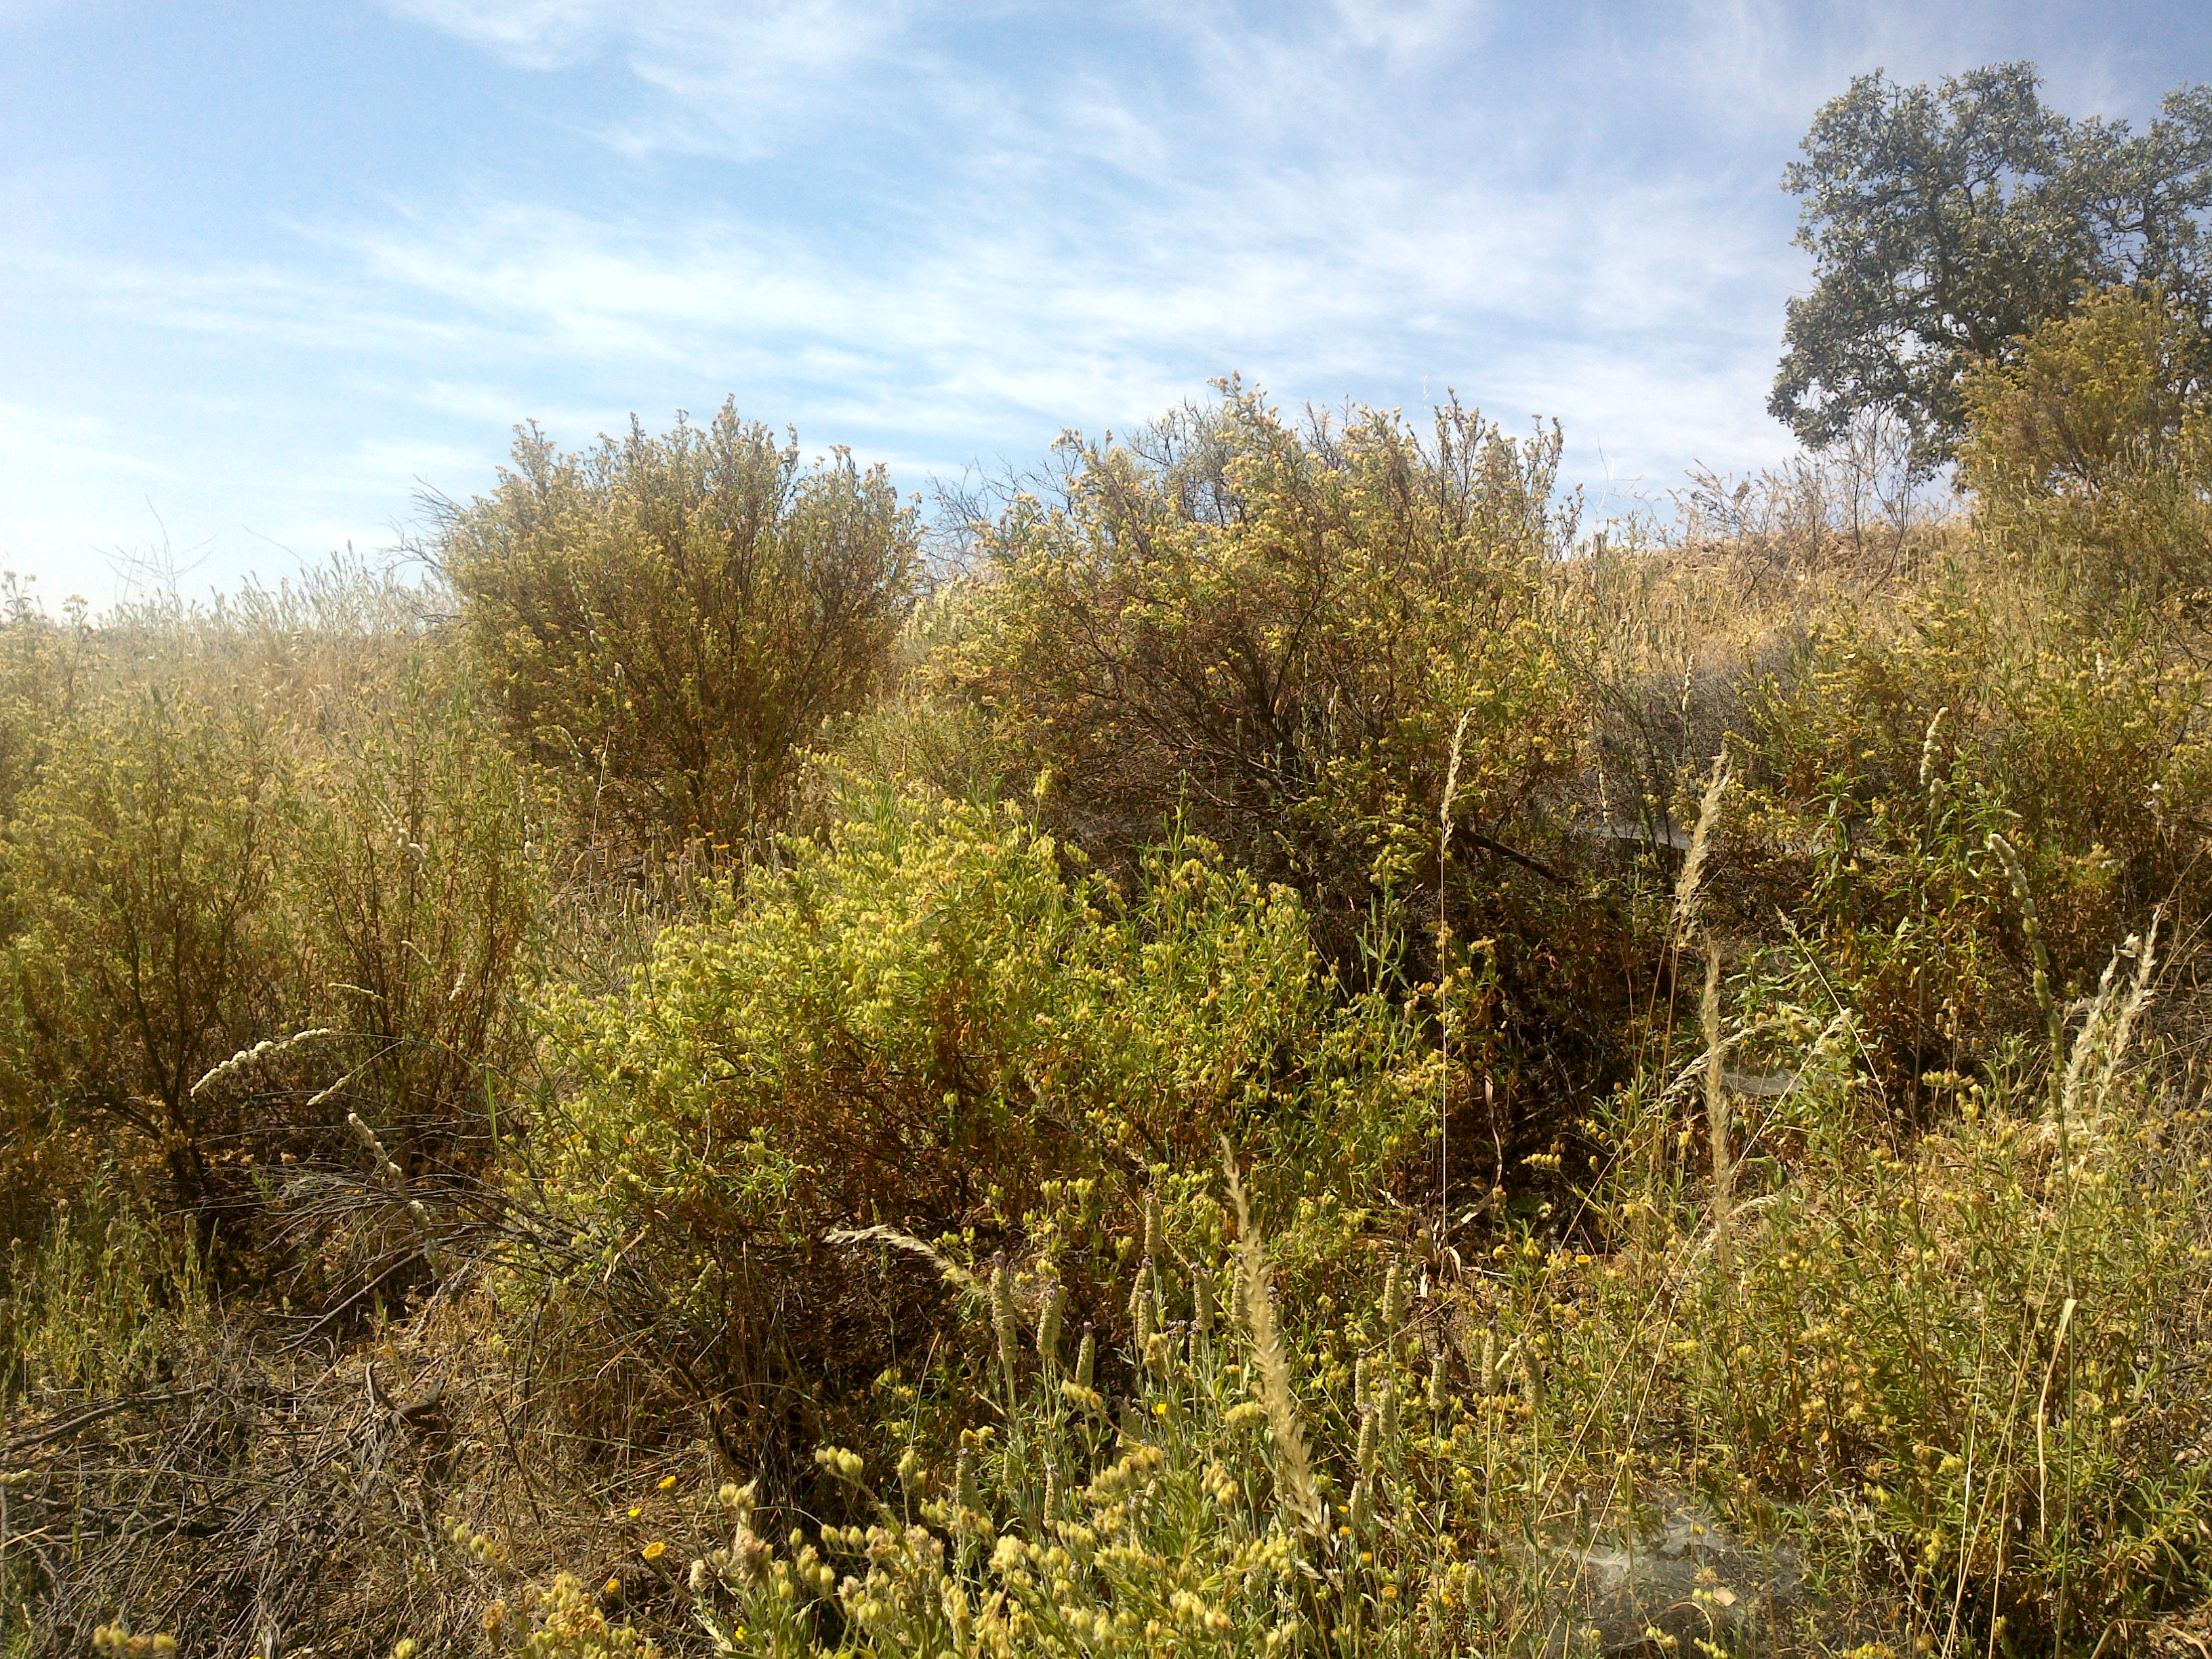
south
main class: Woodland
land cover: Broadleaved woodland
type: broadleaved evergreen forest
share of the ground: 10 - 25 %
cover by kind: shrubs 60 %, broadleaved forest trees 20 %, herbaceous plants 20 %
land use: Semi-natural and natural areas not in use
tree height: < 5 m
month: May
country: ES
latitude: 38.0212
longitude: -4.5373
